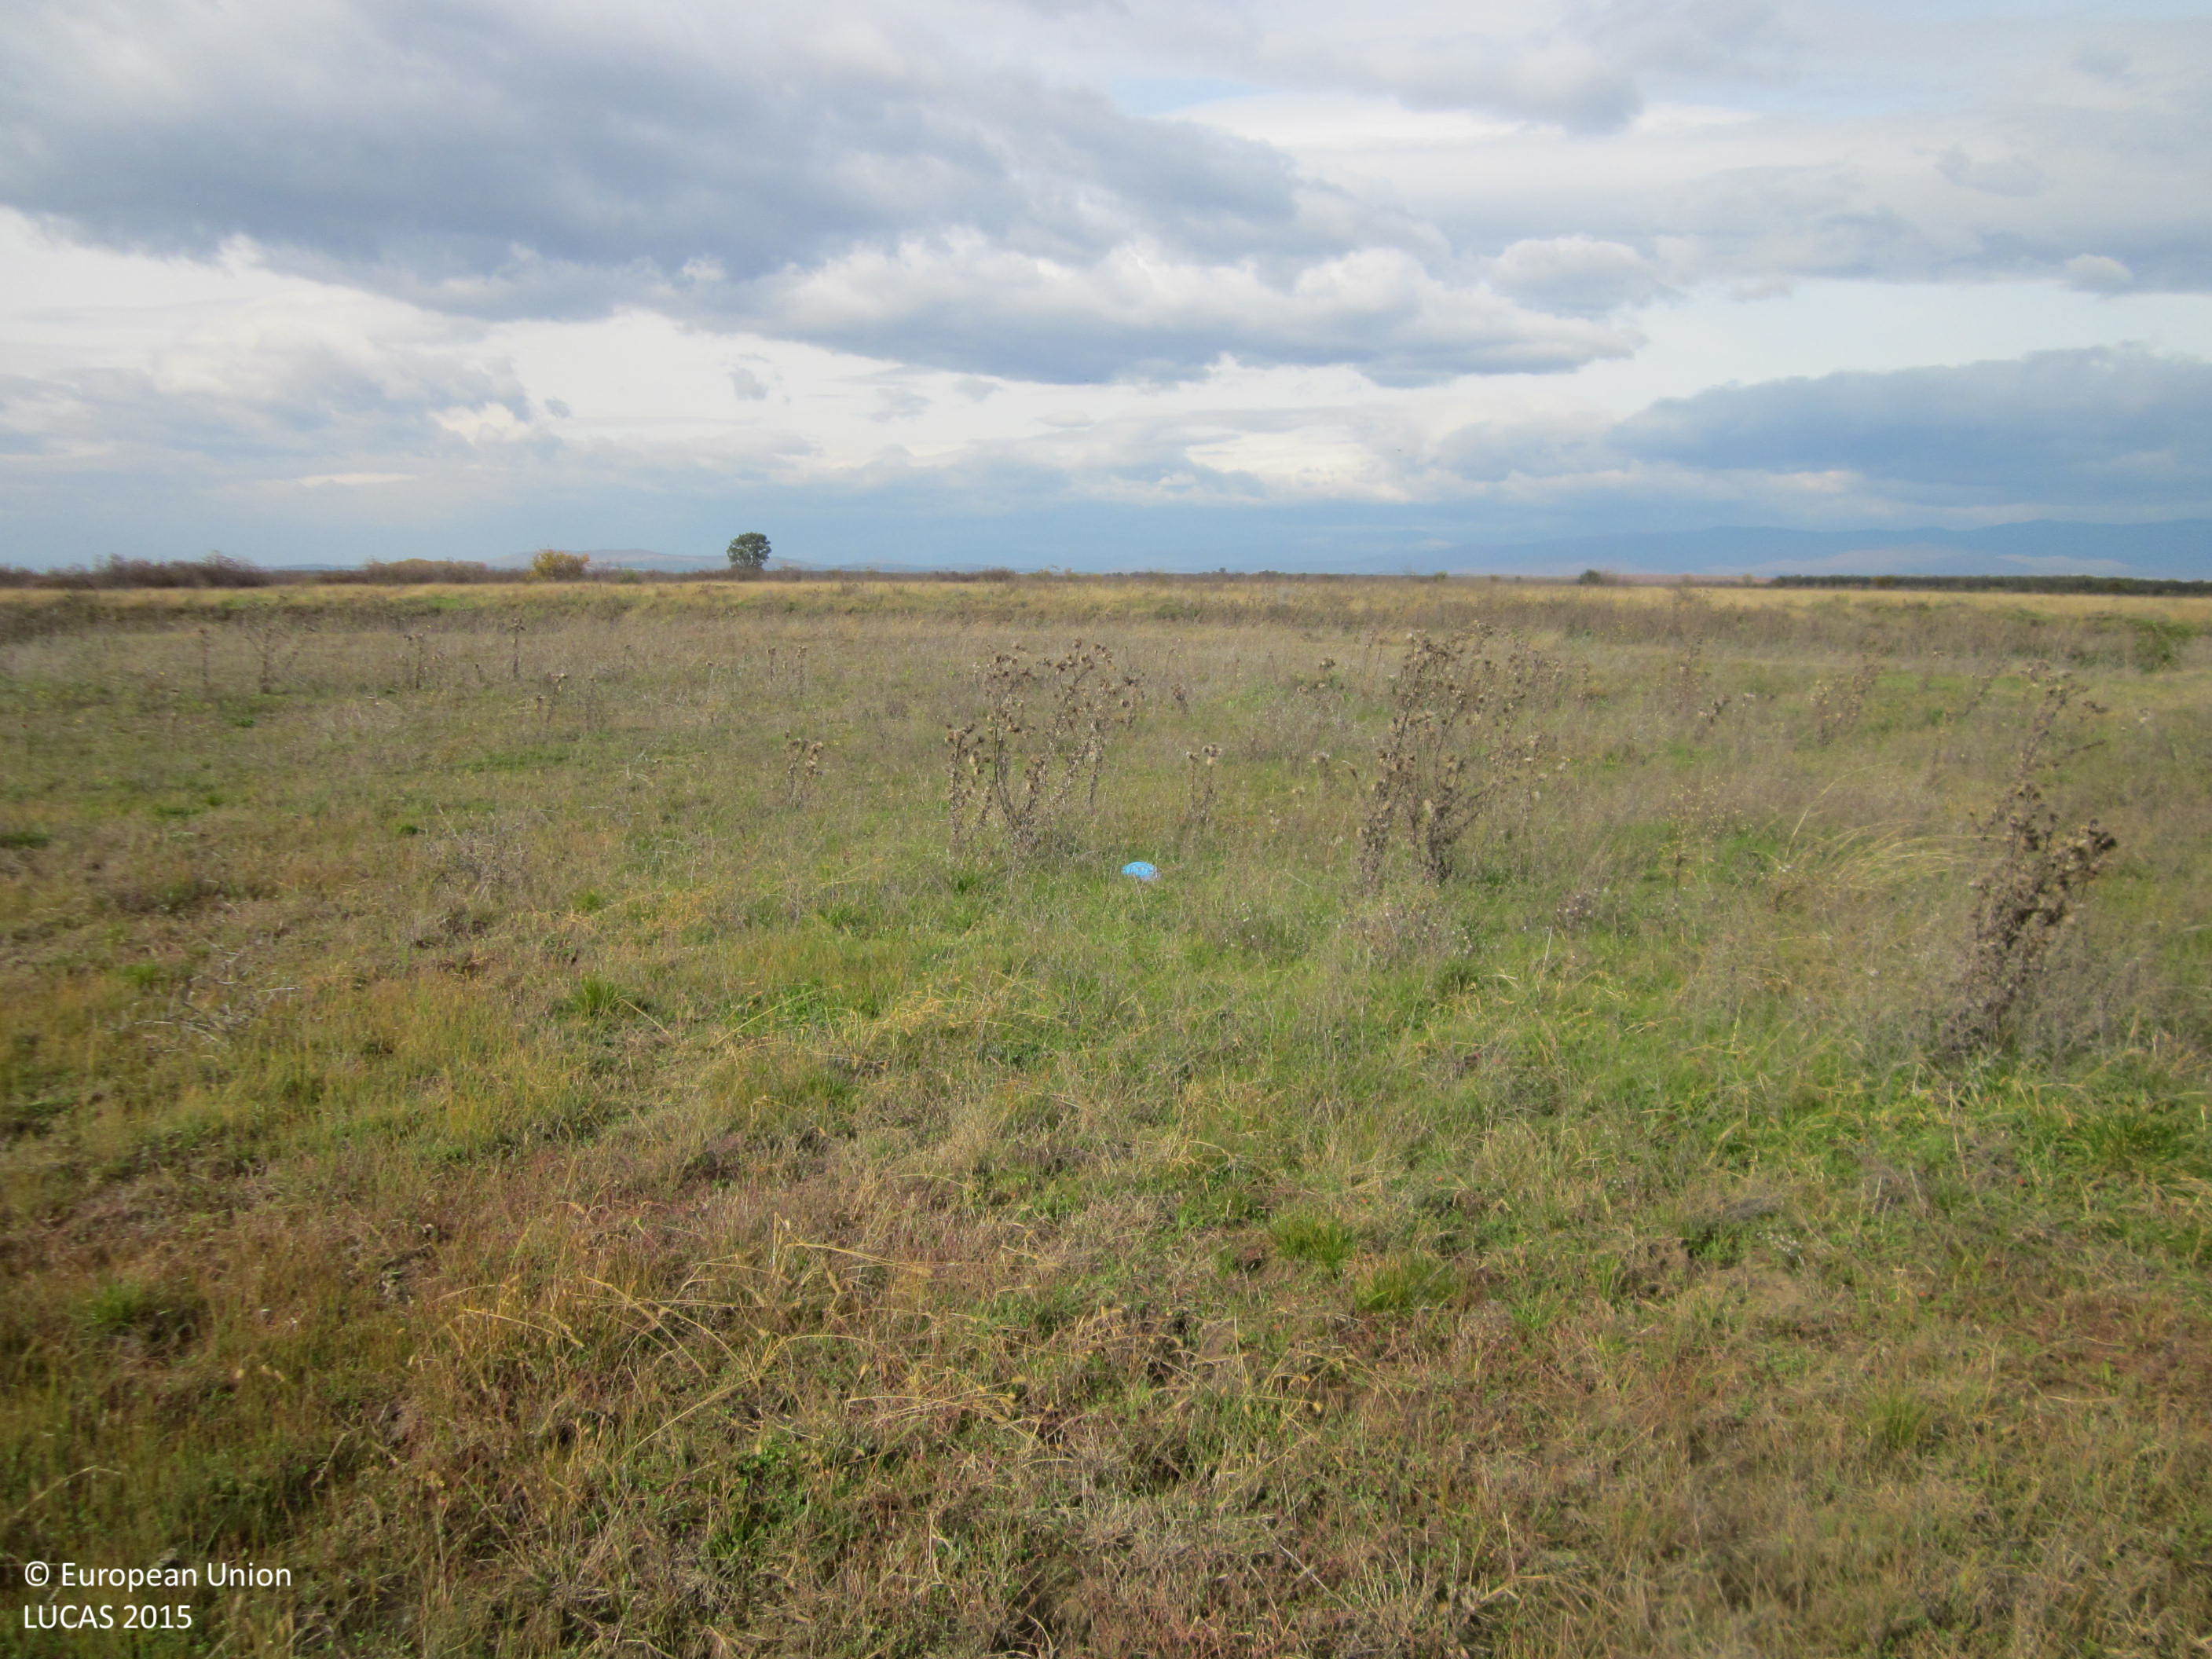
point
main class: Grassland
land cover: Grassland without tree/shrub cover
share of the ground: > 75 %
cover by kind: herbaceous plants 100 %
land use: Agriculture (excluding fallow land and kitchen gardens)
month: November
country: BG
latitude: 42.3402
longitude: 24.6042
